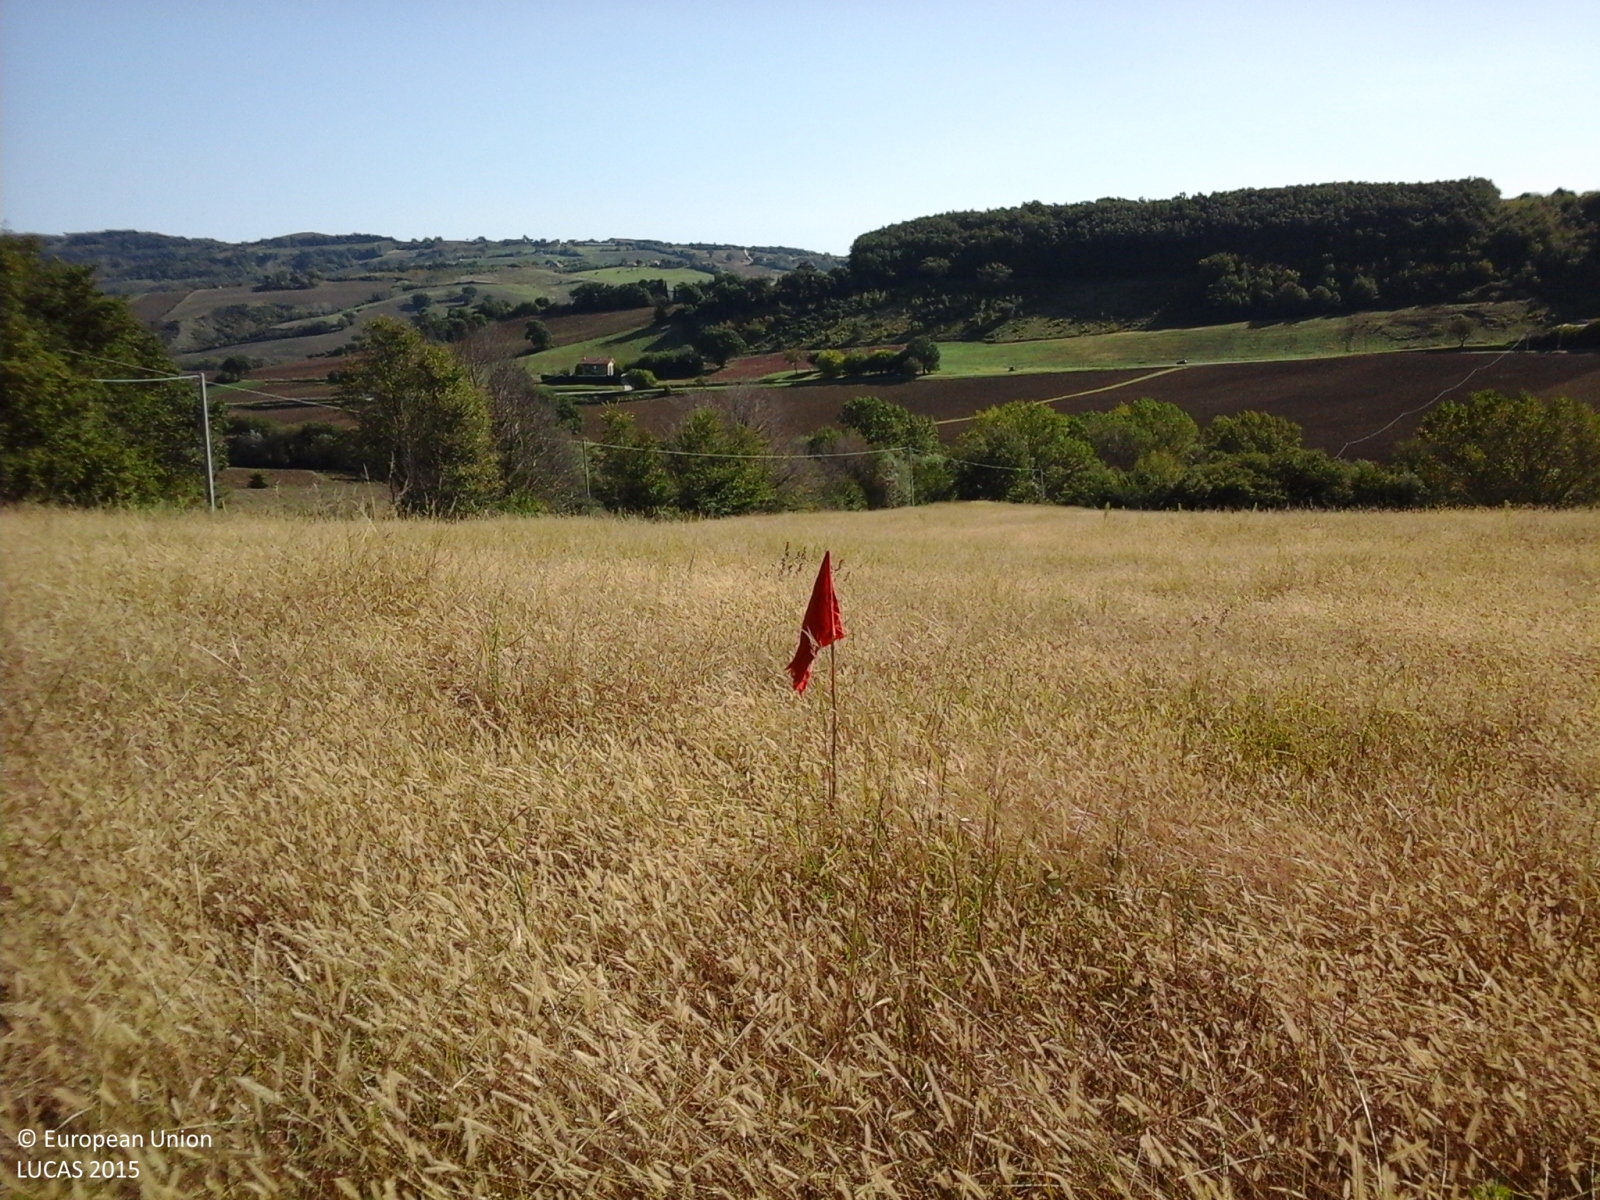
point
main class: Grassland
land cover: Spontaneously vegetated surfaces
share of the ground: > 75 %
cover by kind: herbaceous plants 100 %
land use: Agriculture (excluding fallow land and kitchen gardens)
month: October
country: IT
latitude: 43.4949
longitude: 12.9974
